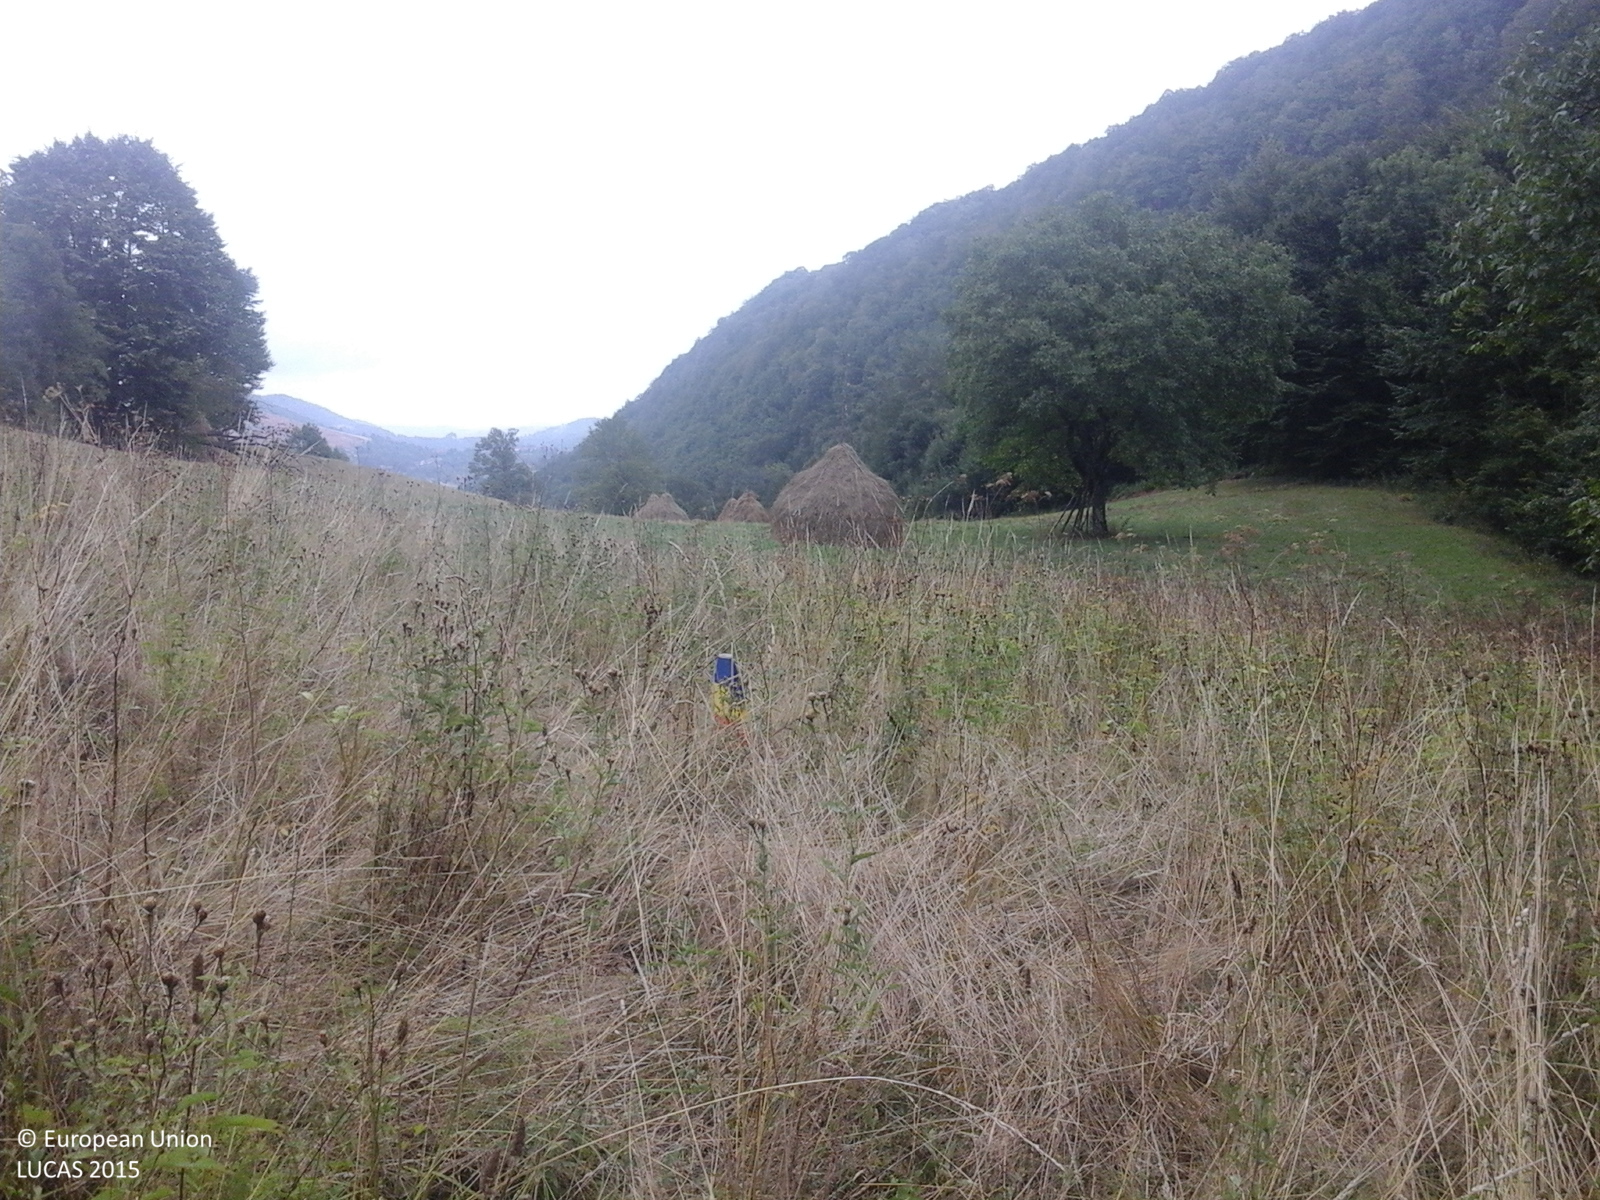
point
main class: Grassland
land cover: Grassland without tree/shrub cover
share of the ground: > 75 %
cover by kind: herbaceous plants 100 %
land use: Agriculture (excluding fallow land and kitchen gardens)
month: August
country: RO
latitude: 45.2420
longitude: 21.9477
